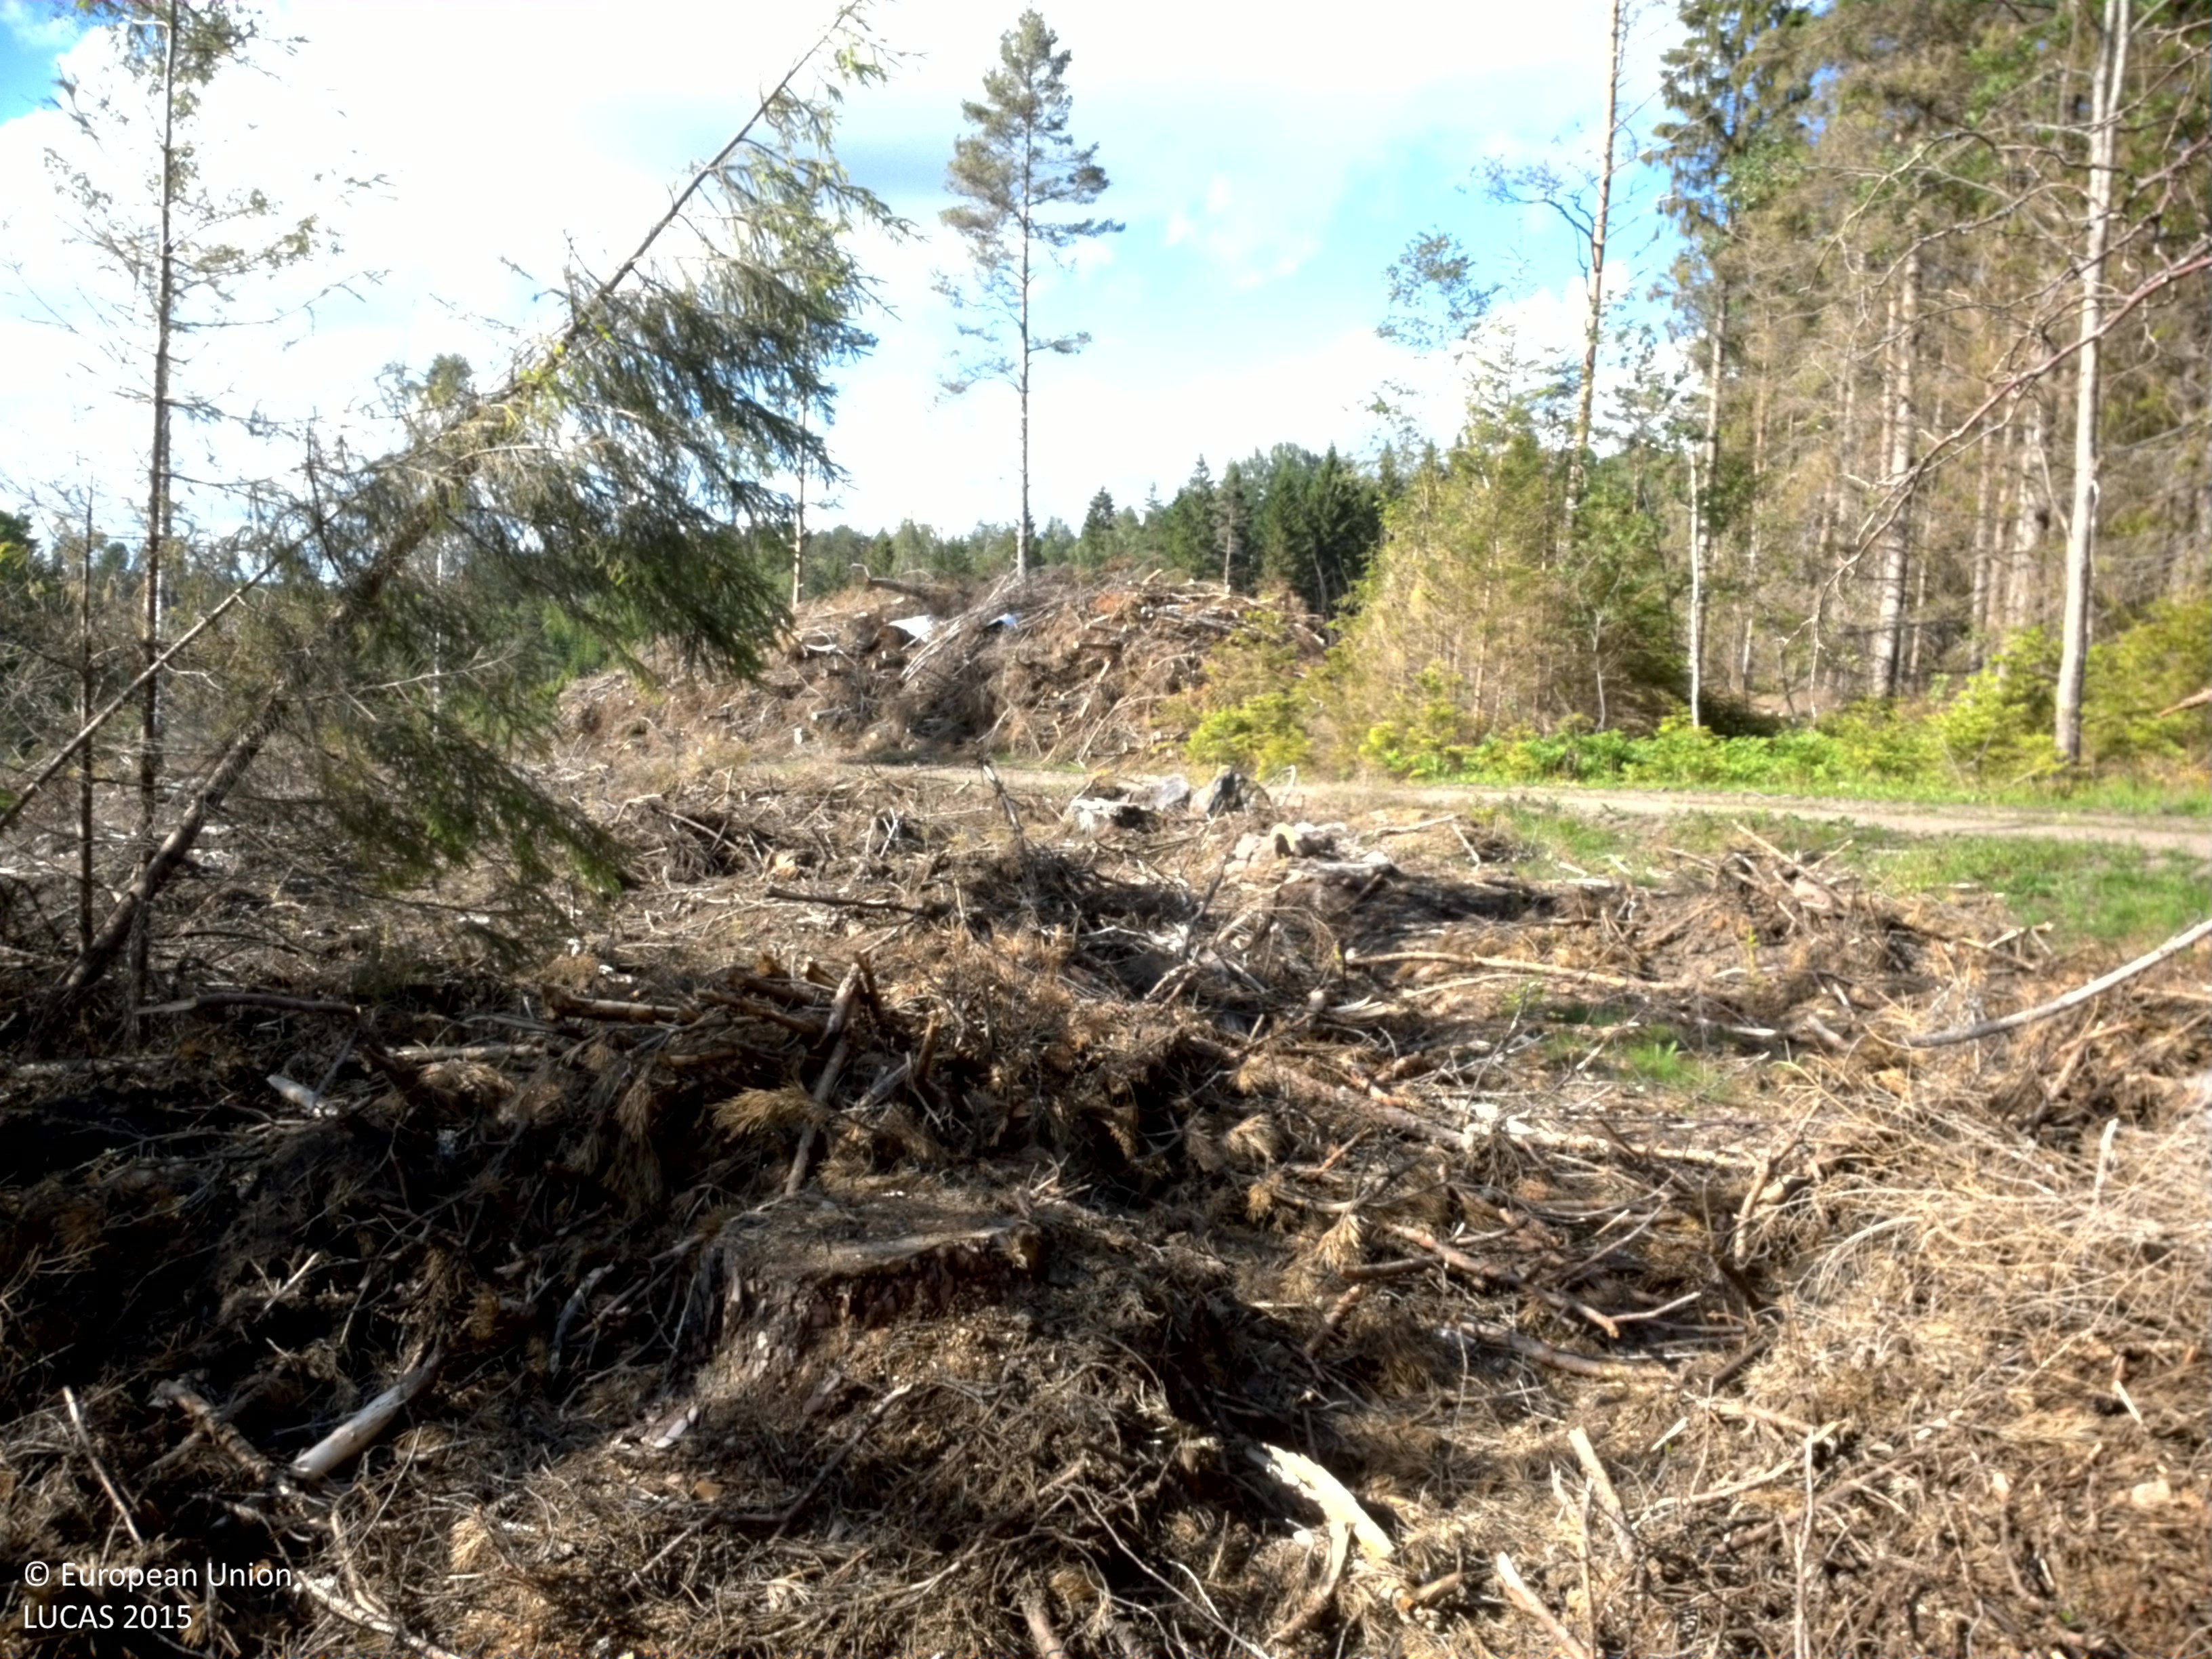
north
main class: Woodland
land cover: Spruce dominated coniferous woodland
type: boreal forest
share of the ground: 10 - 25 %
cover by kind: consolidated bare surface 80 %, coniferous forest trees 10 %, herbaceous plants 10 %
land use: Forestry
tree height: < 5 m
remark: Clear cut
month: June
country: SE
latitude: 58.5725
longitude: 15.5823
